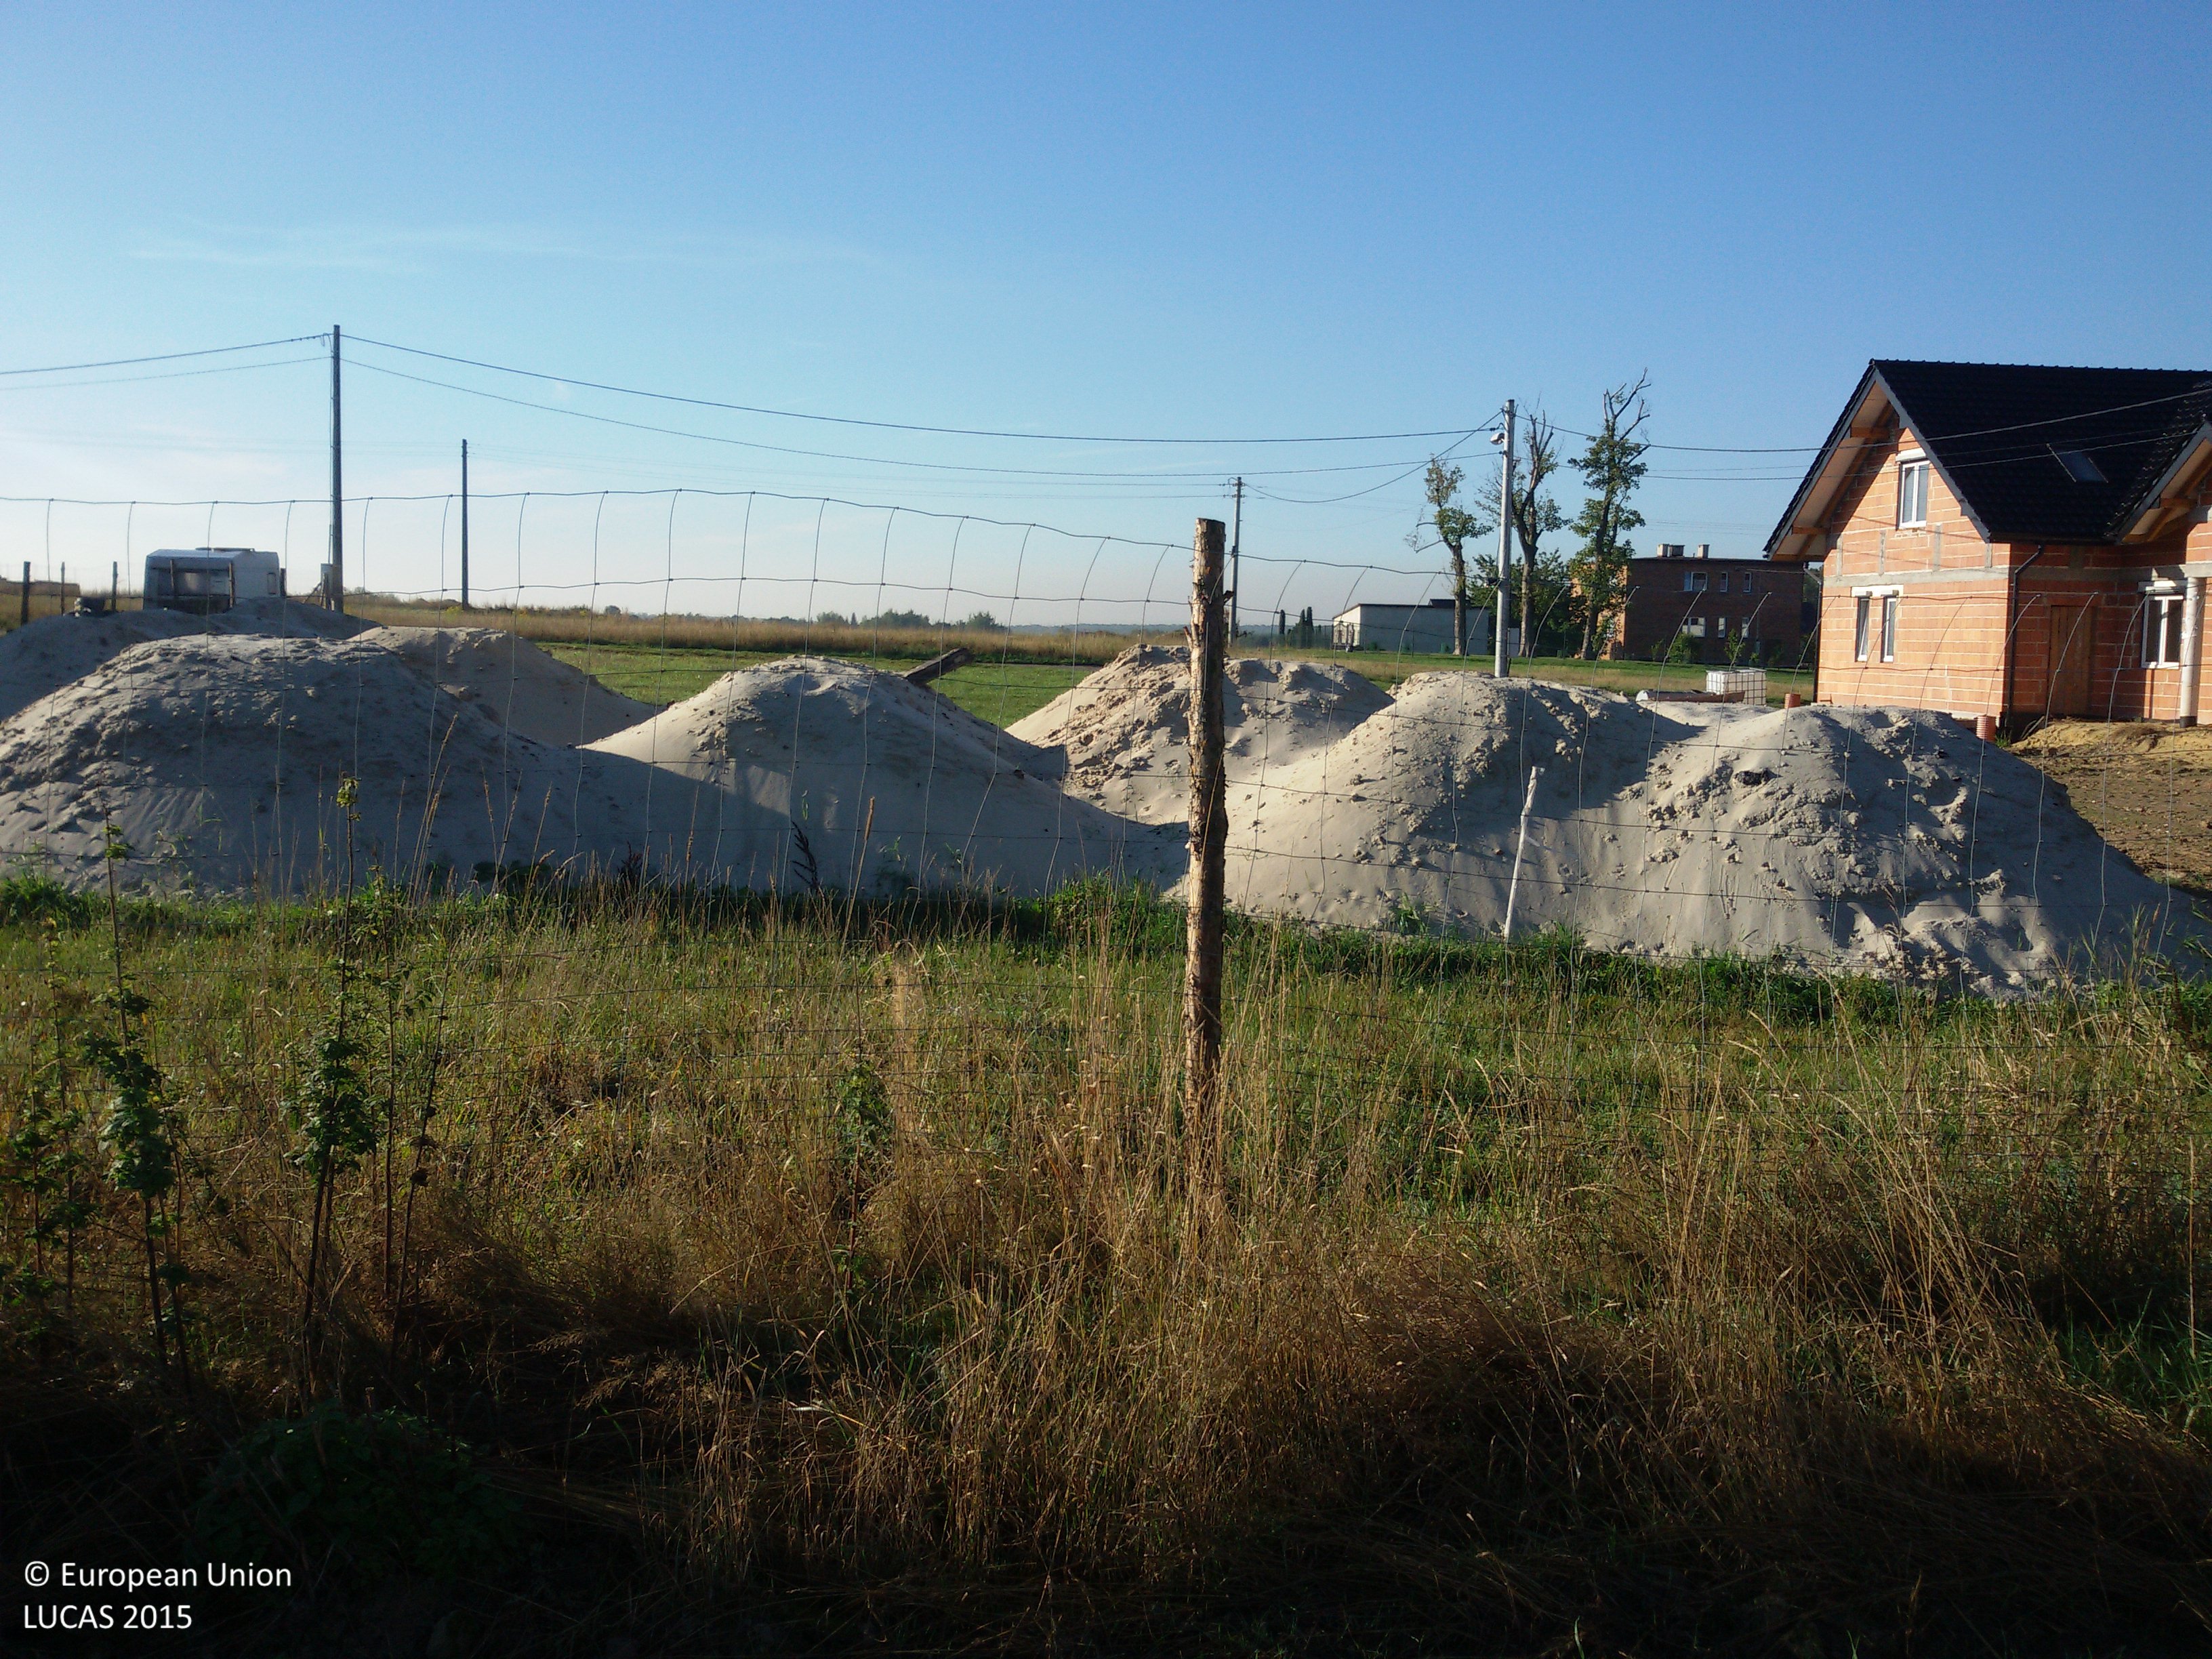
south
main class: Cropland
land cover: Rape and turnip rape
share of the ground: < 10 %
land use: Agriculture (excluding fallow land and kitchen gardens)
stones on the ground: < 10 %
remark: Harvested field
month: September
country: PL
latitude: 50.2375
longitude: 18.6145
